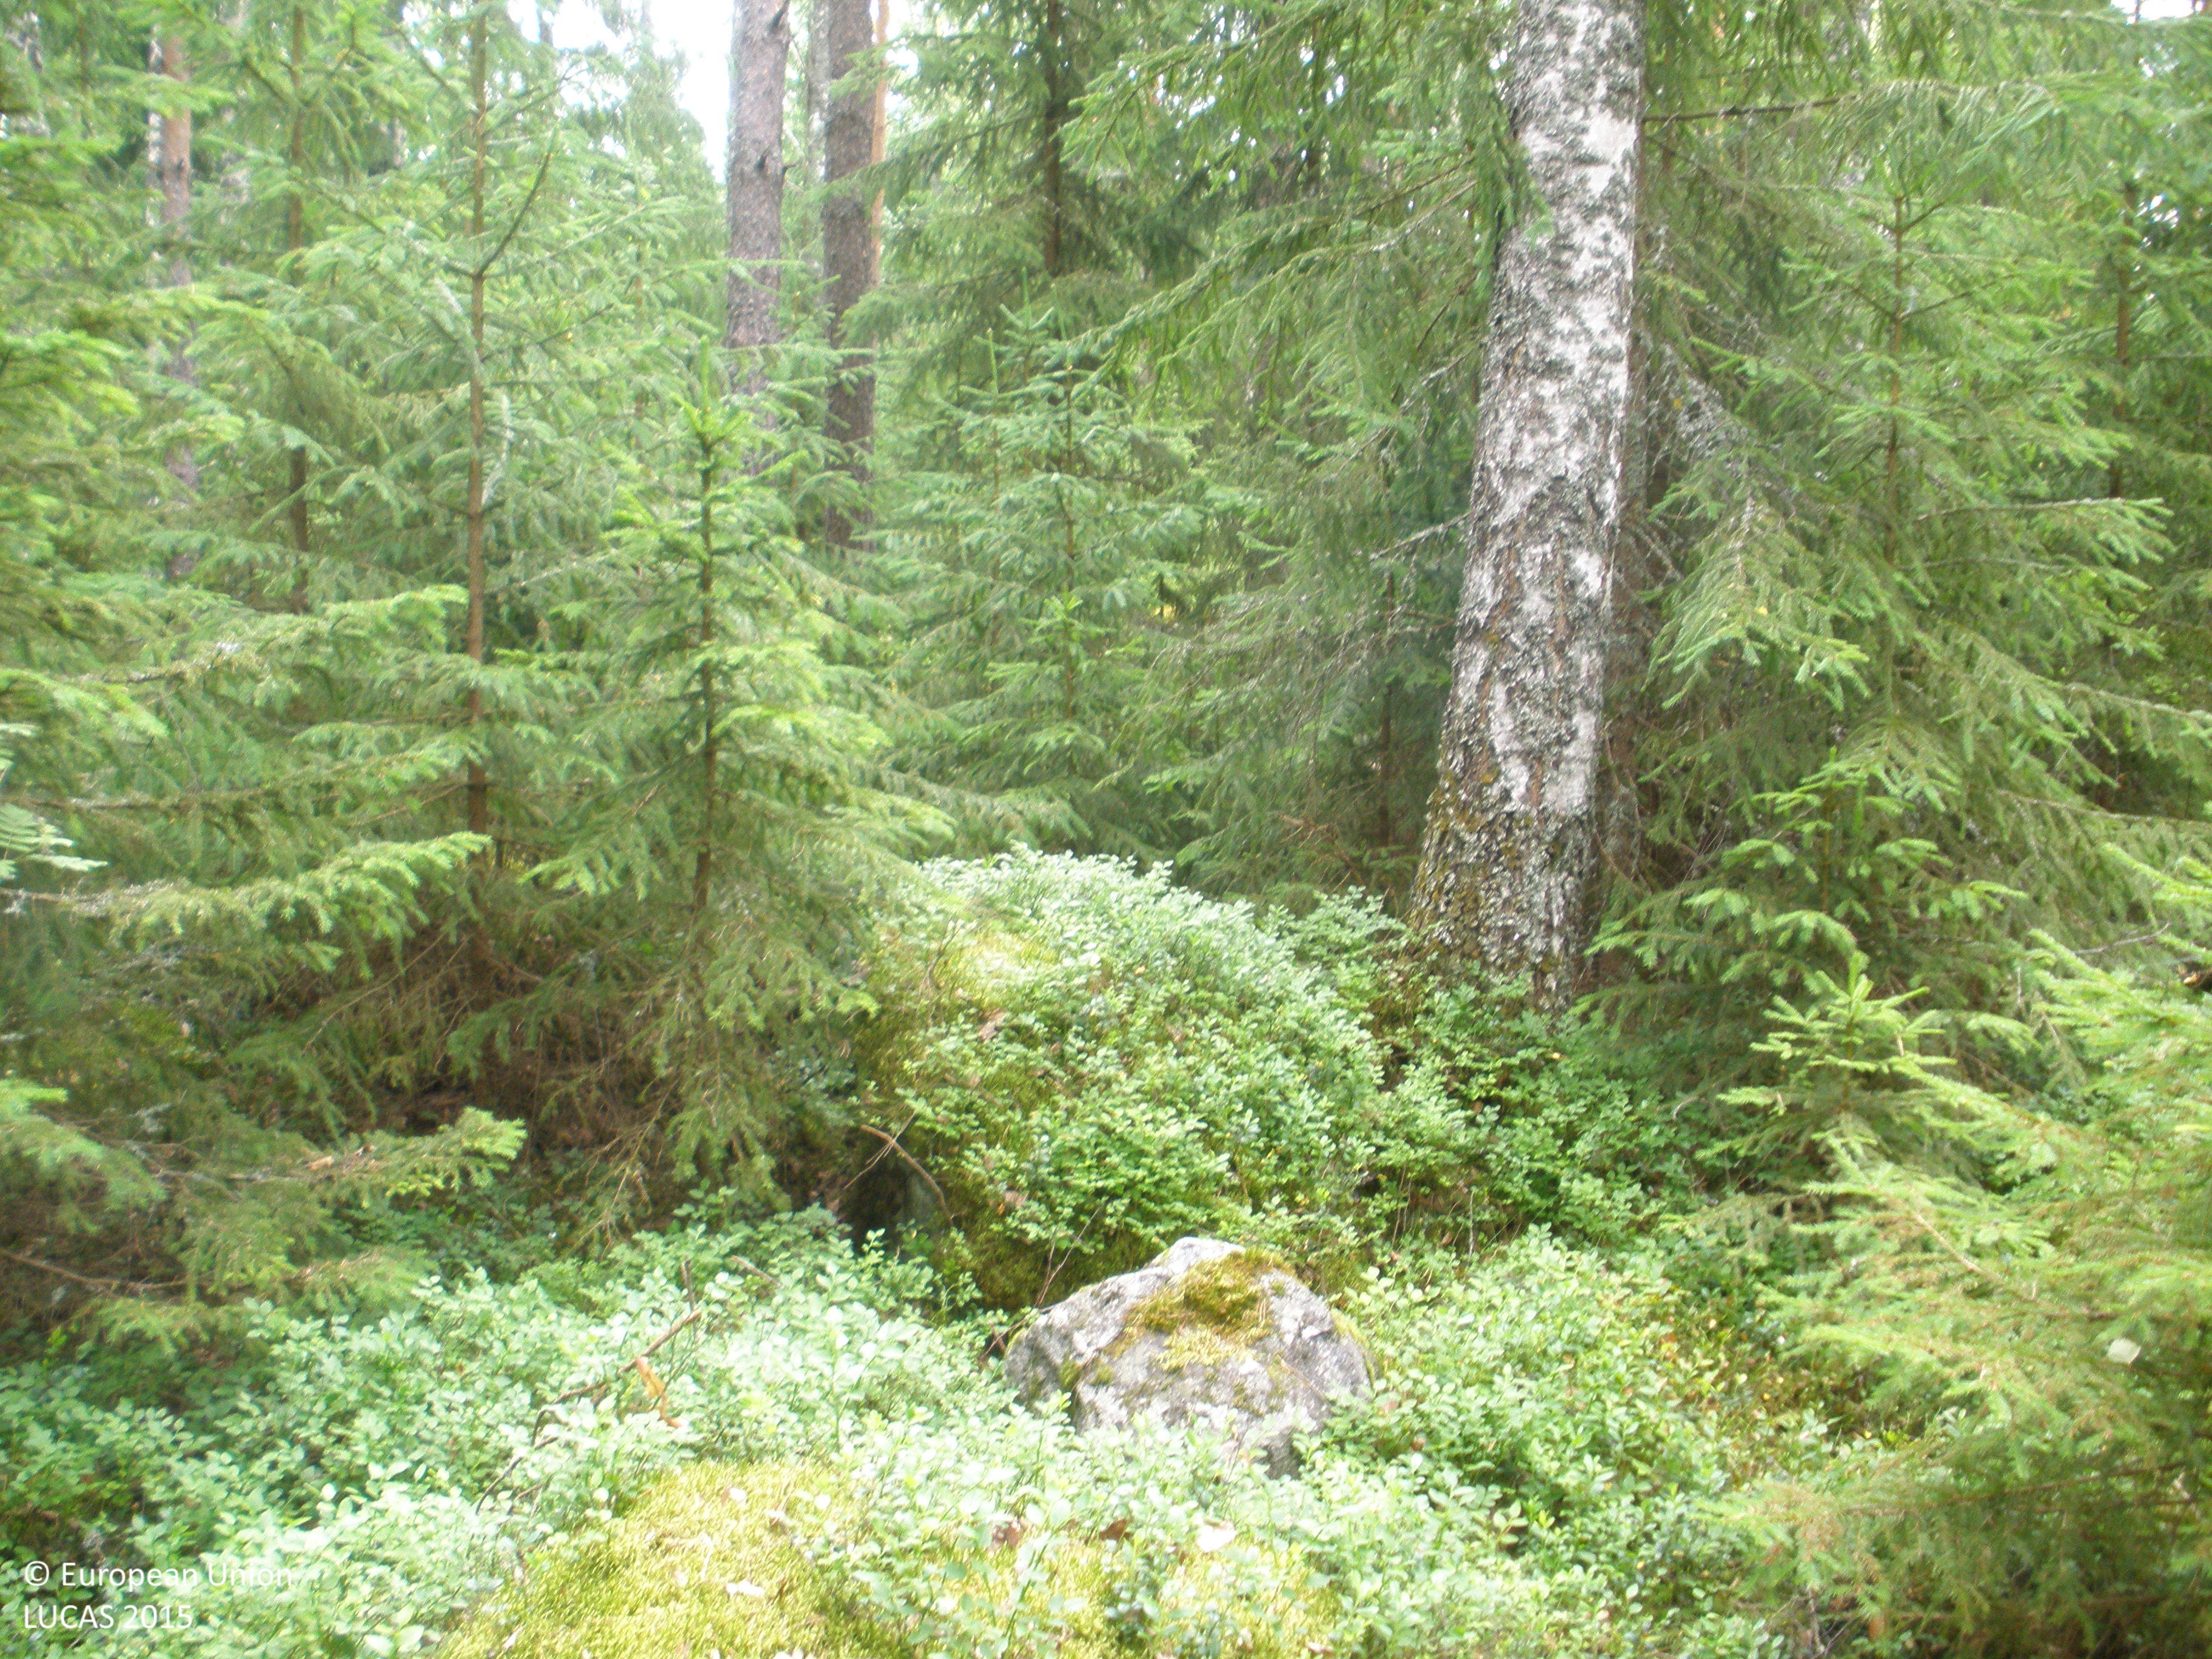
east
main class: Woodland
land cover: Other coniferous woodland
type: boreal forest
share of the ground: > 75 %
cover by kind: coniferous forest trees 70 %, broadleaved forest trees 15 %, lichens and mosses 10 %, herbaceous plants 5 %
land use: Forestry
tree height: > 5 m
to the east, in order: Other coniferous woodland; Other mixed woodland; Spruce dominated mixed woodland; Artificial constructions in urban areas; Spruce dominated coniferous woodland
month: July
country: FI
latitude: 60.9083
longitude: 23.2252
